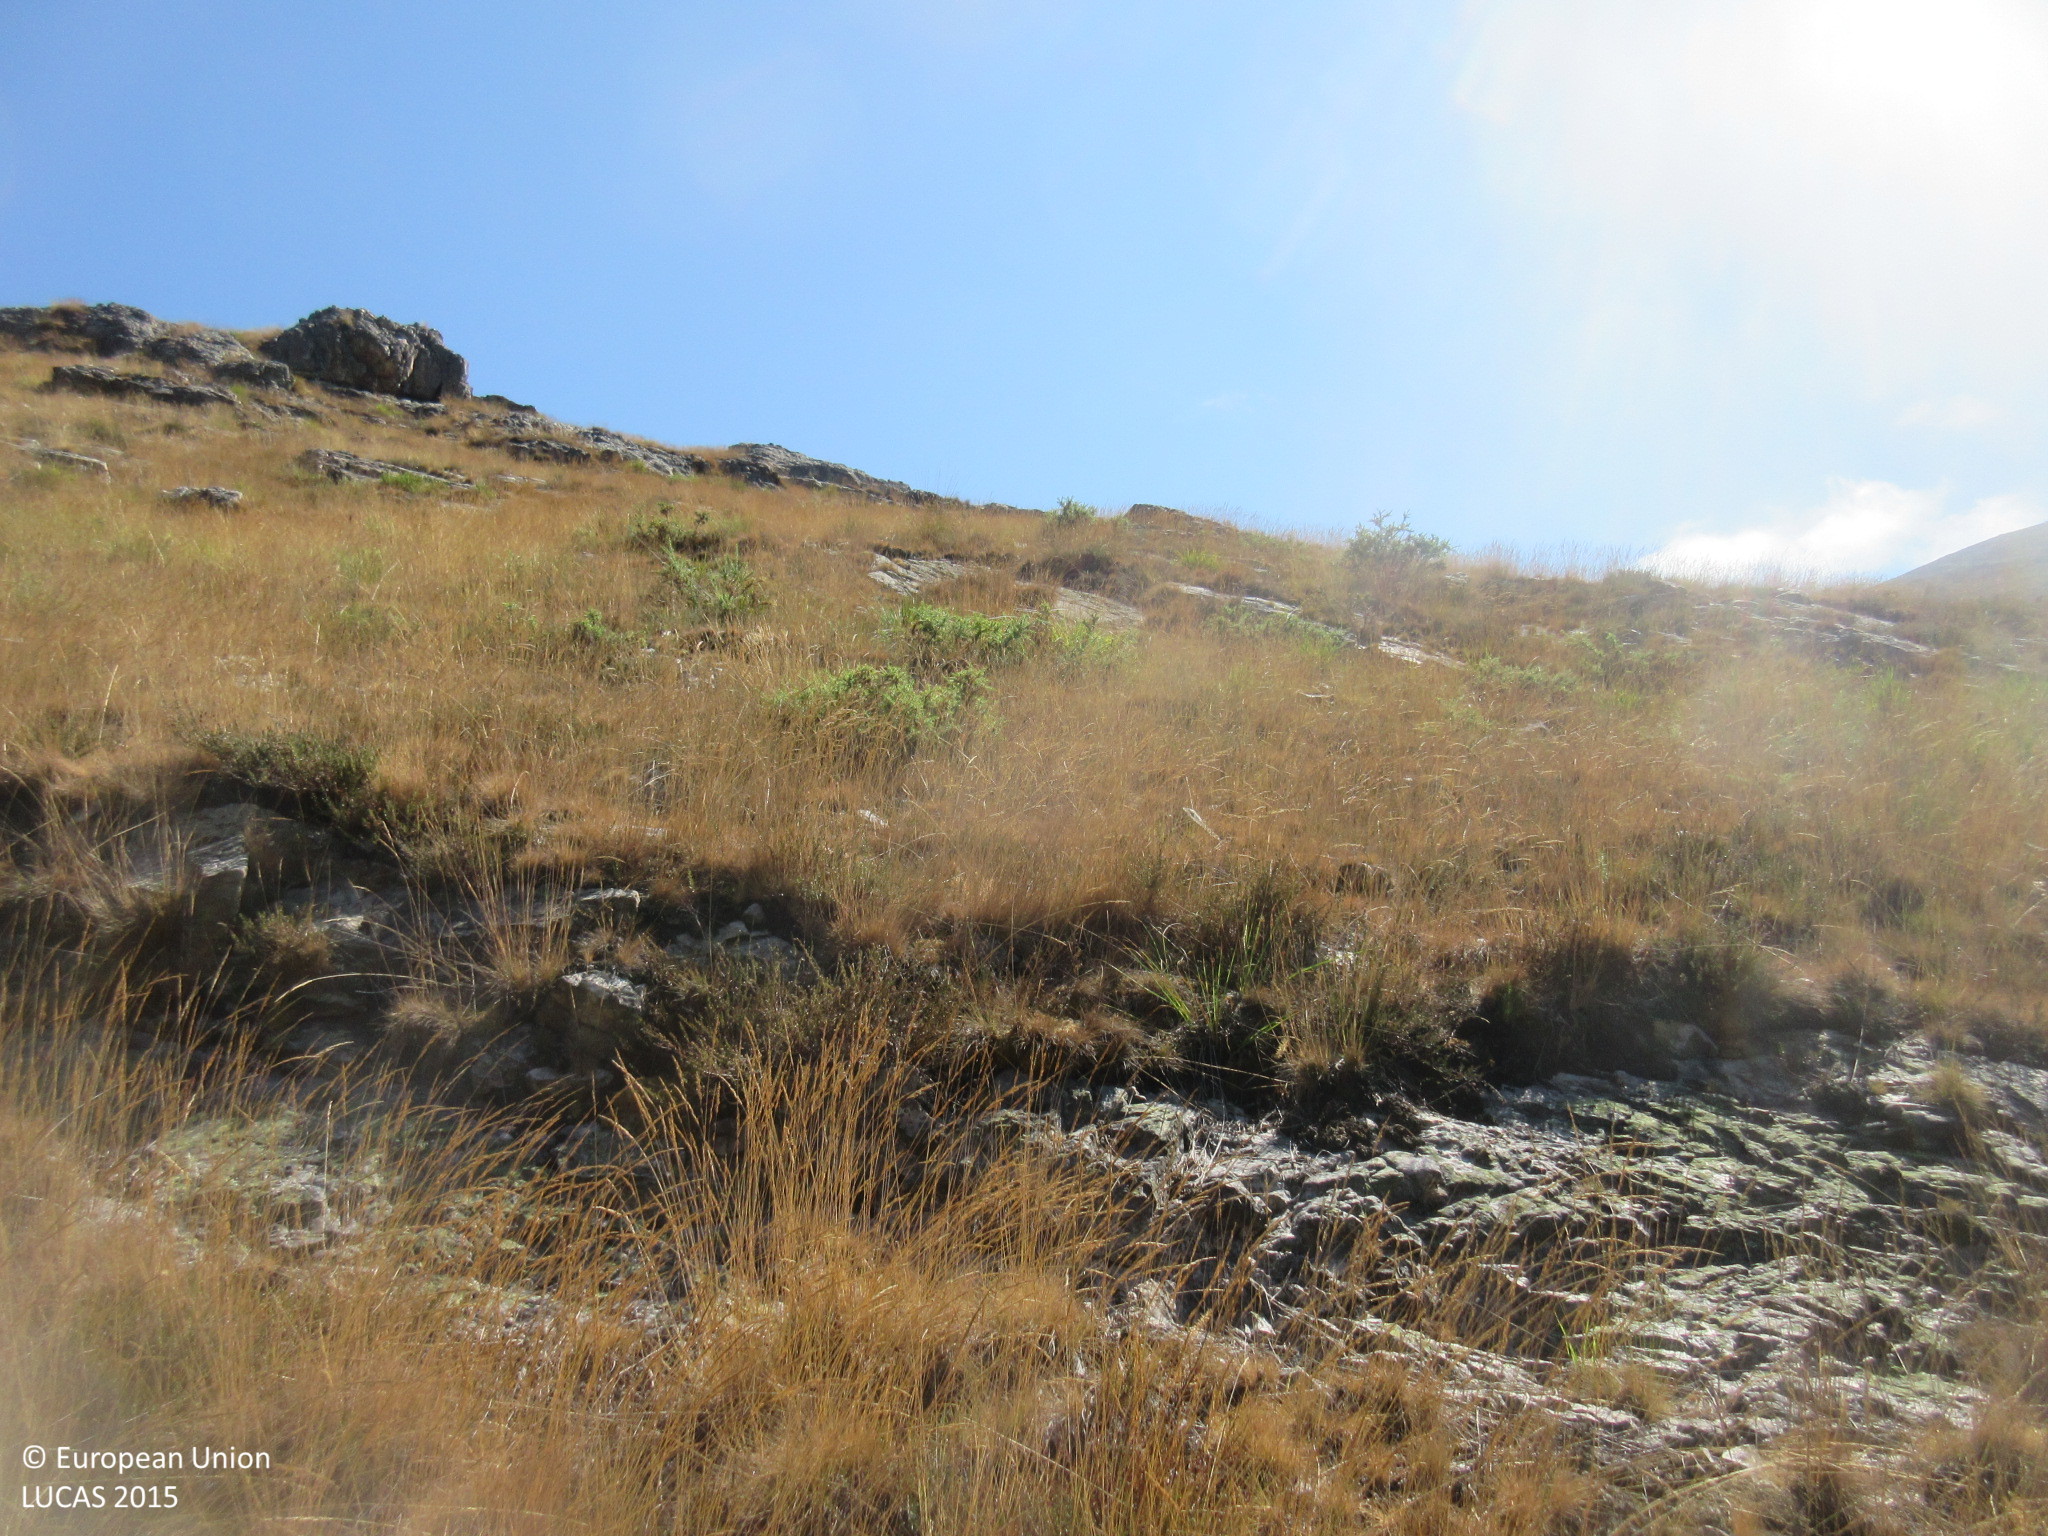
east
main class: Grassland
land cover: Grassland without tree/shrub cover
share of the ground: > 75 %
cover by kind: herbaceous plants 95 %, consolidated bare surface 5 %
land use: Agriculture (excluding fallow land and kitchen gardens)
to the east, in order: Grassland without tree/shrub cover; Rocks and stones; Grassland without tree/shrub cover; Rocks and stones; Grassland without tree/shrub cover
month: July
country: ES
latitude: 43.2226
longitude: -5.2029
